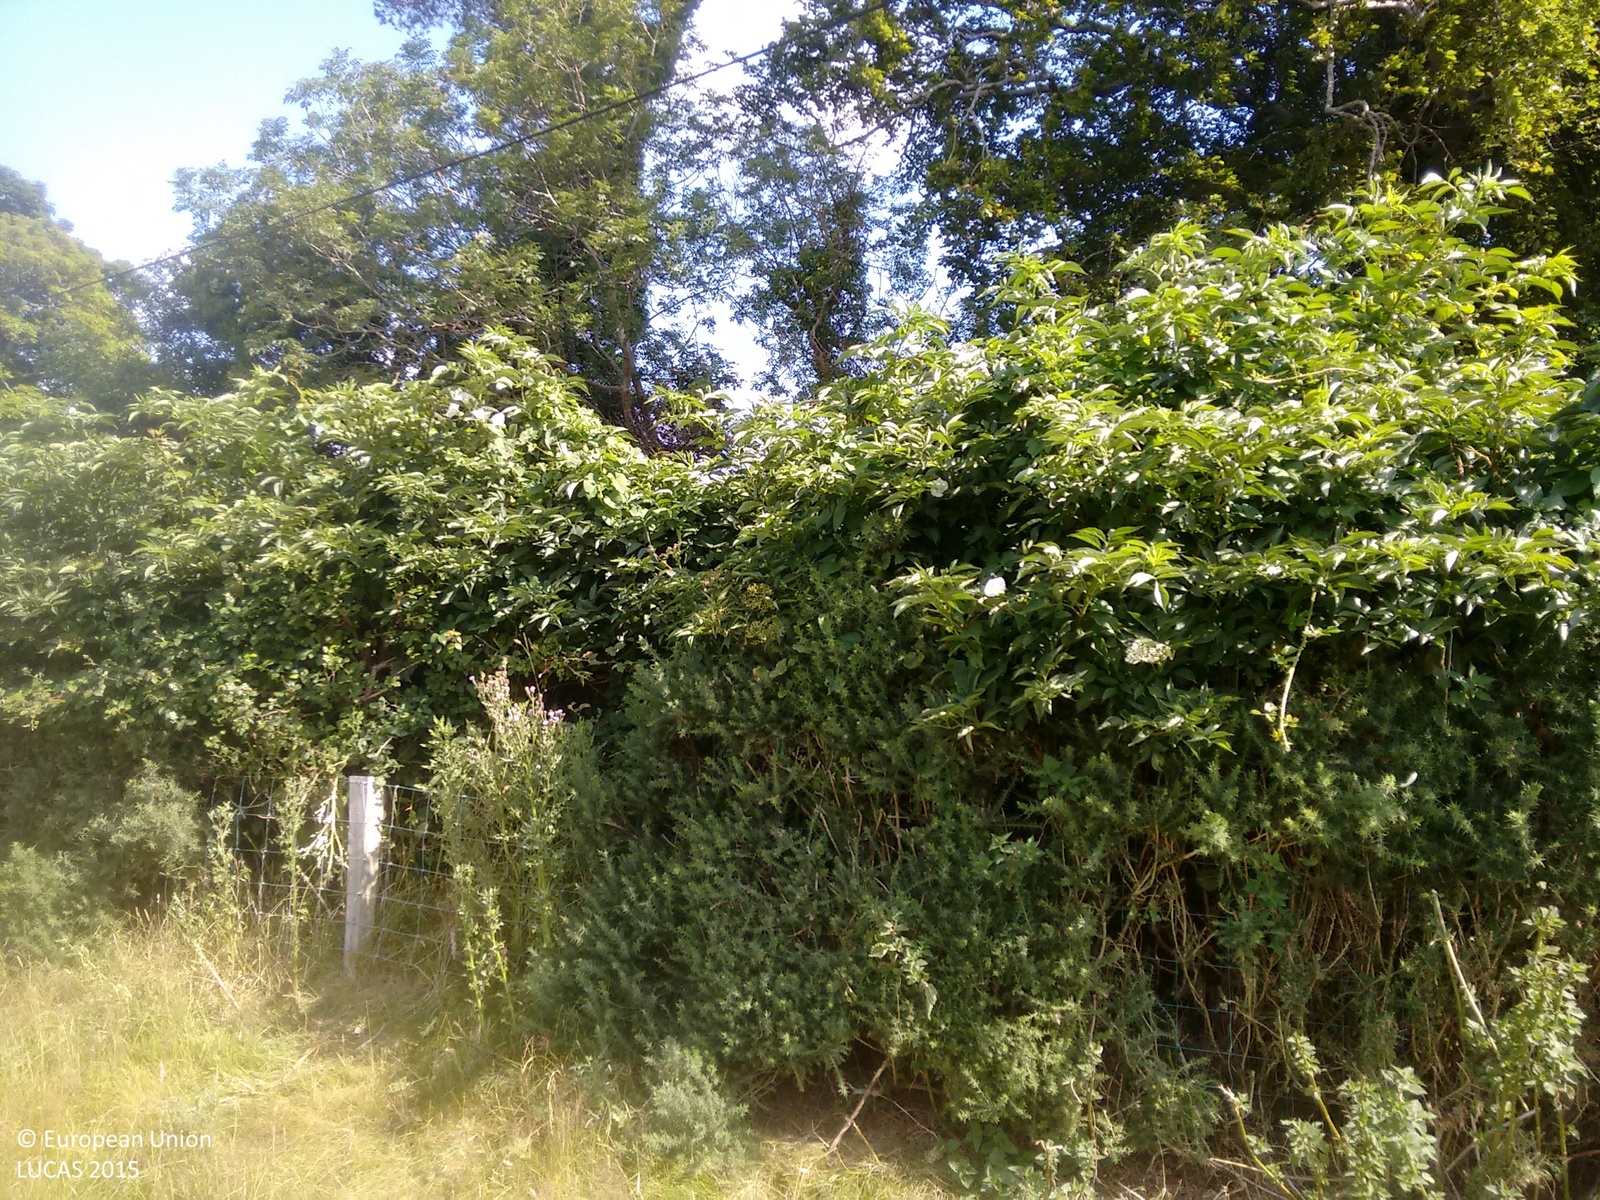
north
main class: Grassland
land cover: Grassland without tree/shrub cover
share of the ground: > 75 %
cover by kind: herbaceous plants 100 %
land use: Agriculture (excluding fallow land and kitchen gardens)
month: July
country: IE
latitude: 53.1583
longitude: -6.1030
